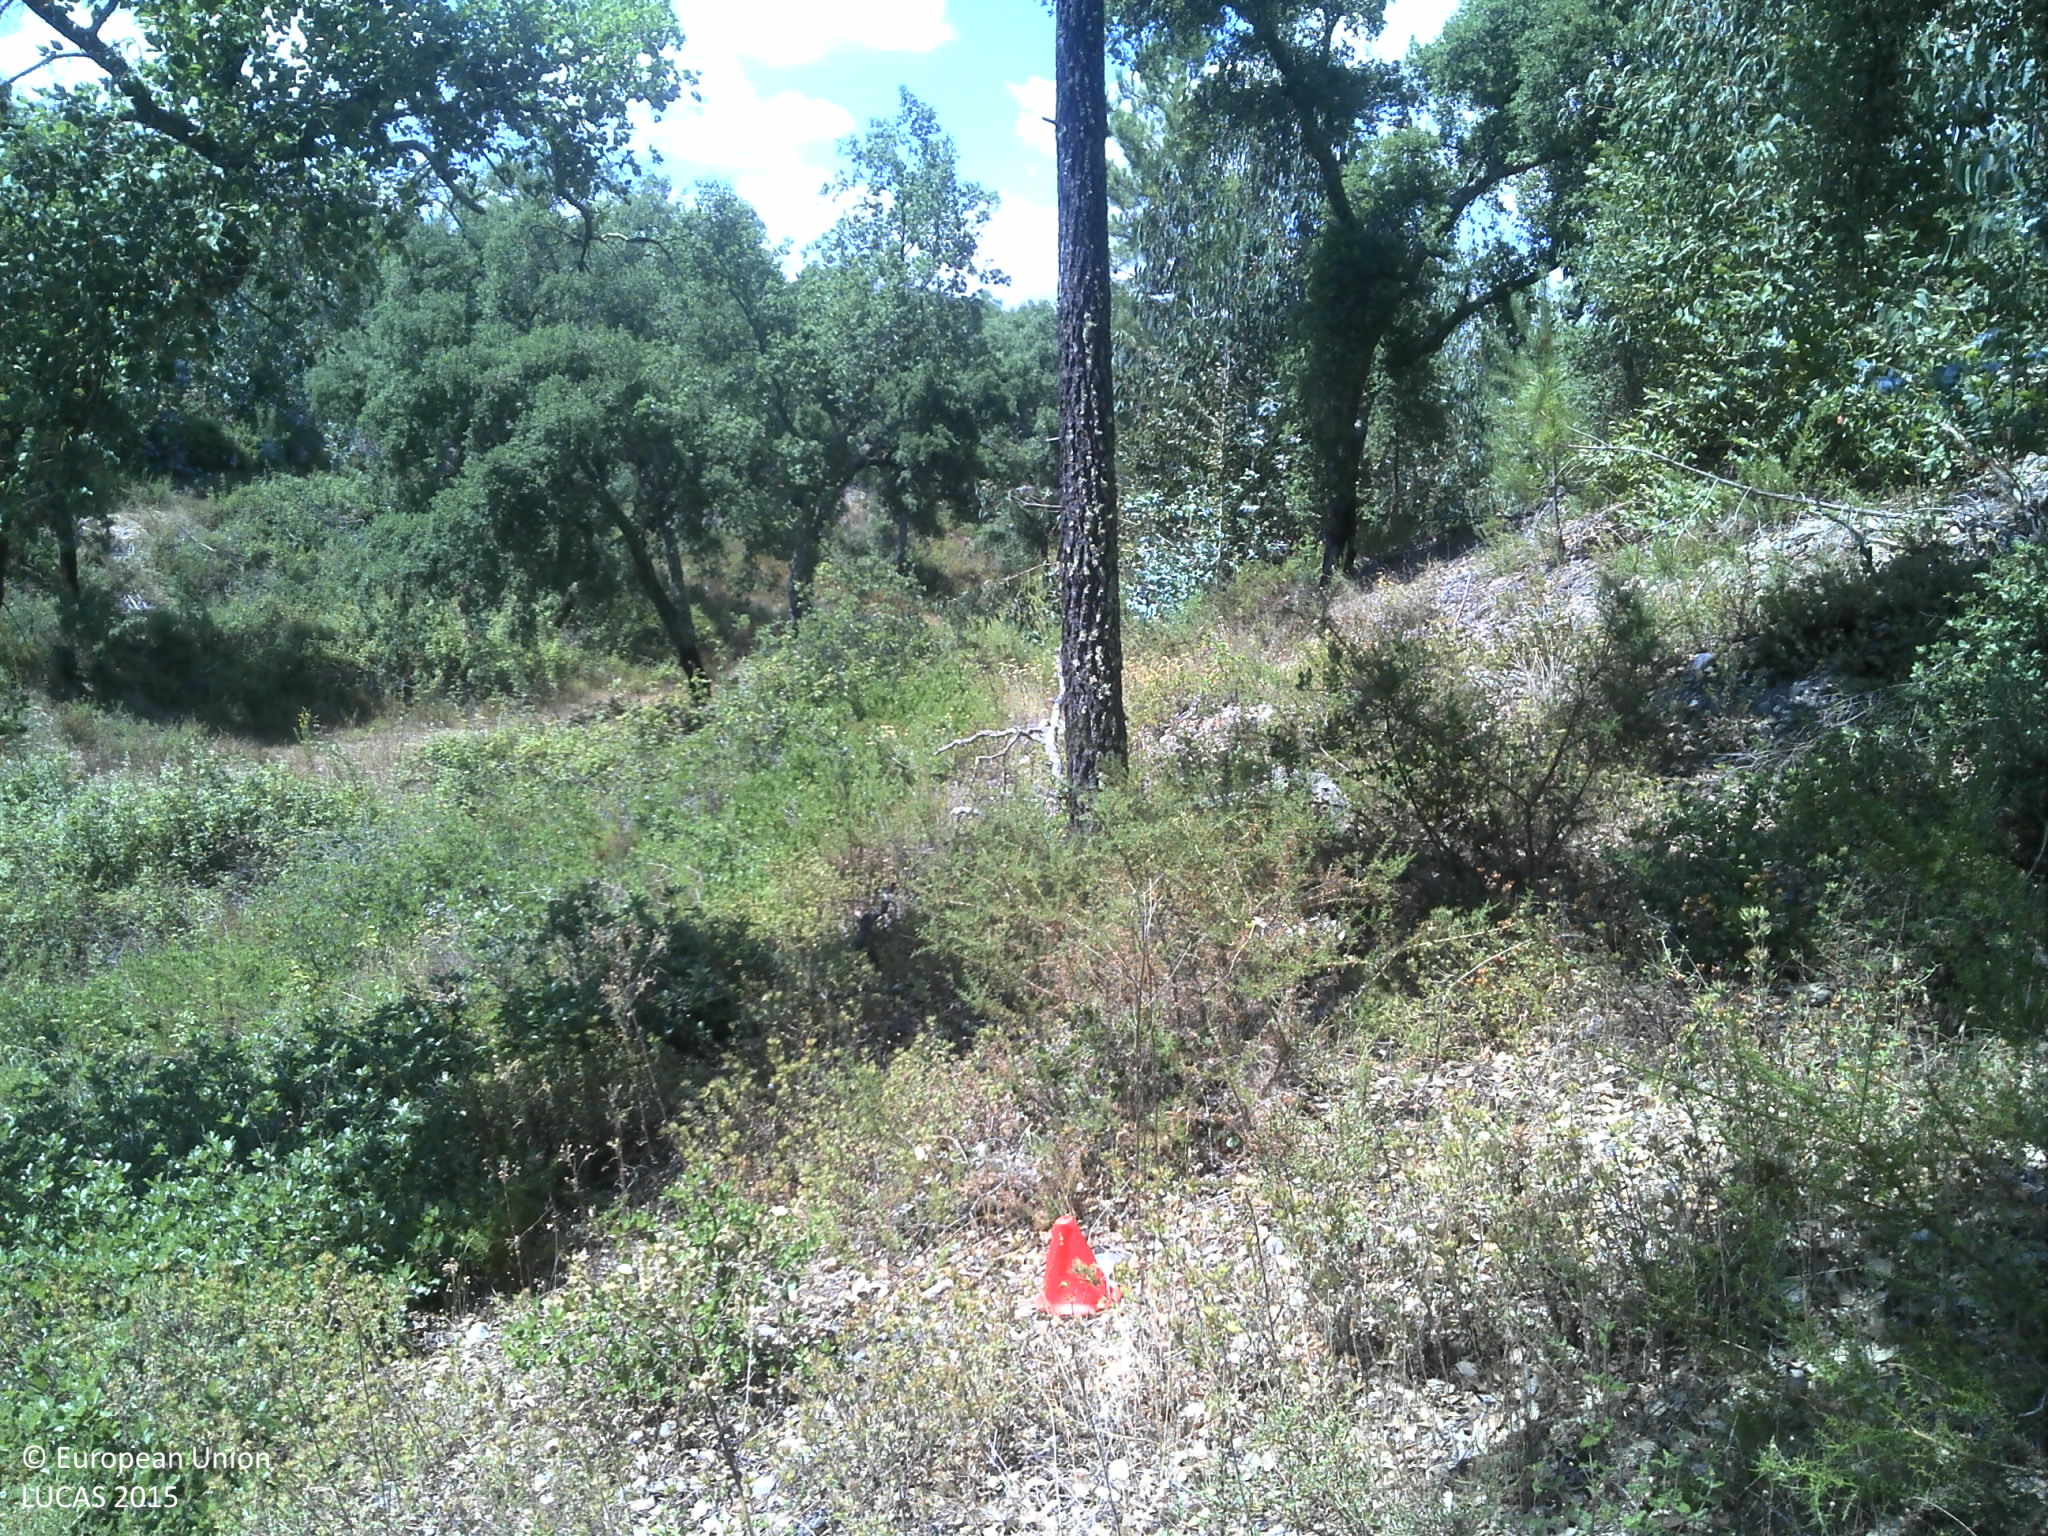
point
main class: Woodland
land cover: Broadleaved woodland
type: broadleaved evergreen forest
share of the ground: 25 - 50 %
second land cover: Grassland without tree/shrub cover
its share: 25 - 50 %
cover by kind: broadleaved forest trees 50 %, unconsolidated bare surface 20 %, shrubs 15 %, herbaceous plants 15 %
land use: Forestry
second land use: Agriculture (excluding fallow land and kitchen gardens)
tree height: > 5 m
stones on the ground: 10 - 25 %
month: June
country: PT
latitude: 39.2832
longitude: -8.2274
